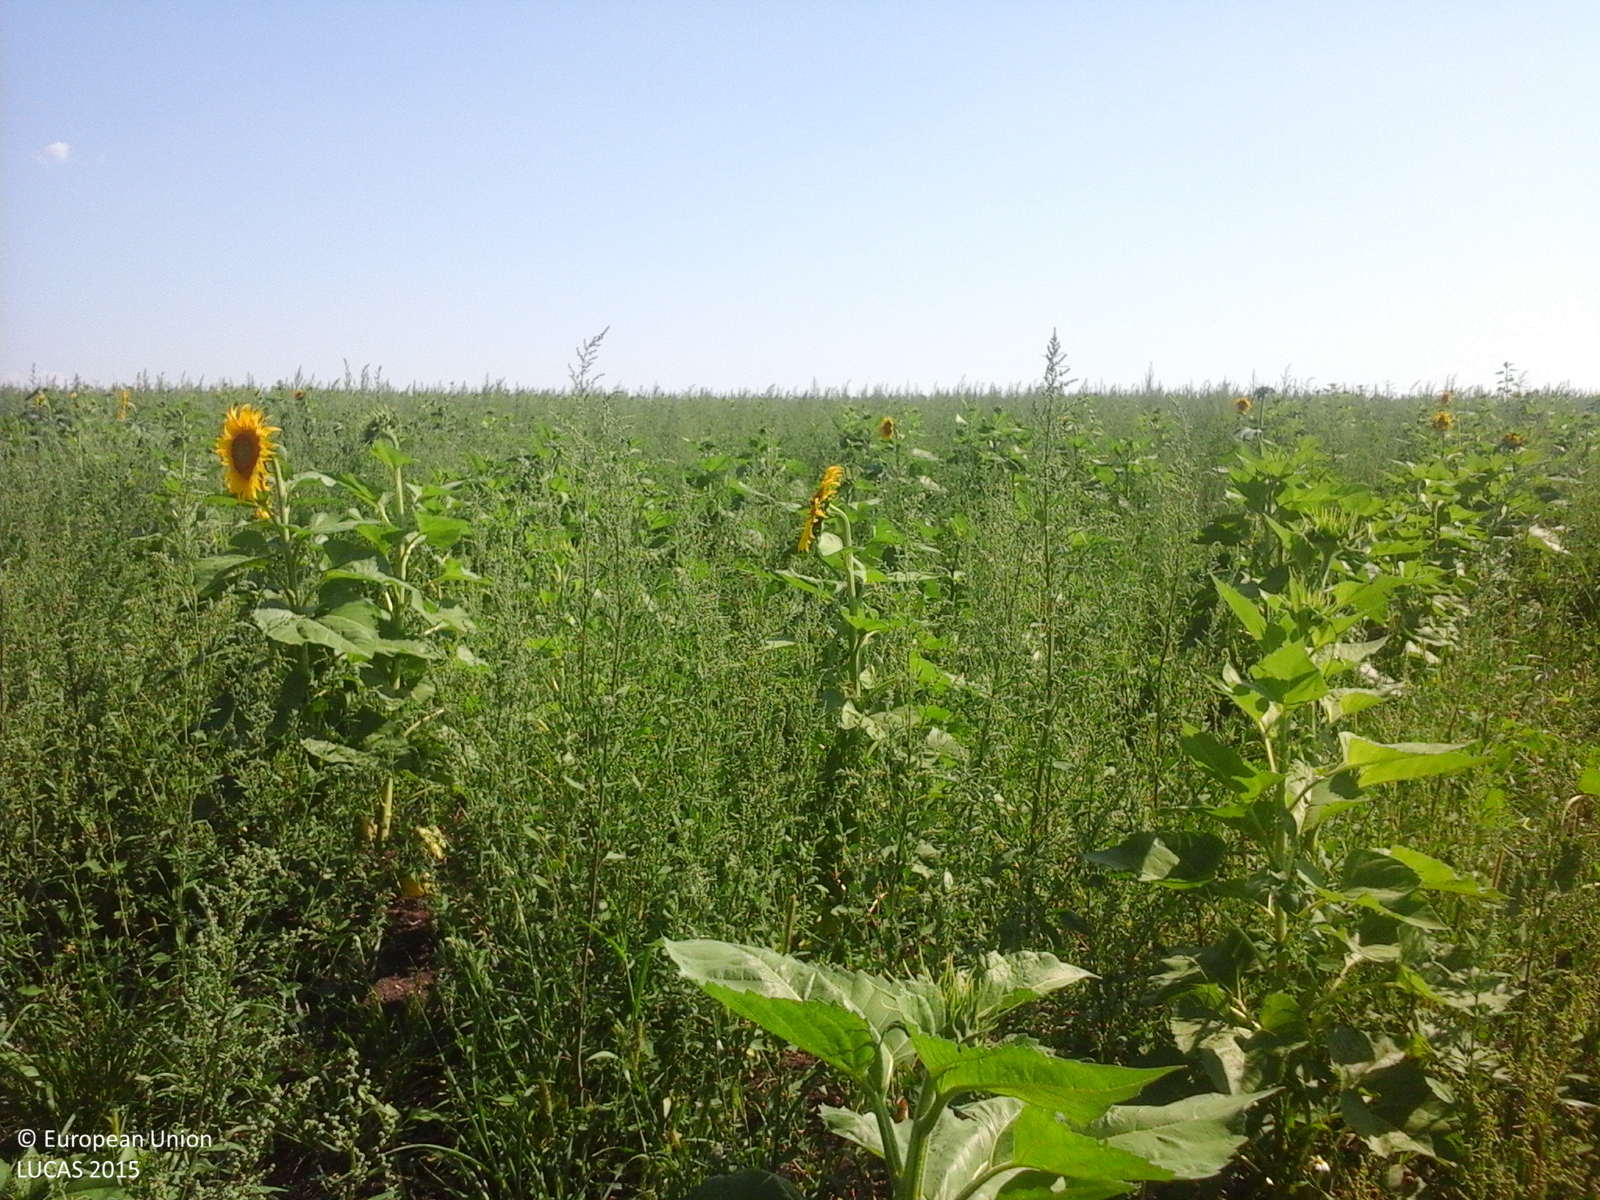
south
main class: Grassland
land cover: Spontaneously vegetated surfaces
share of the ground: > 75 %
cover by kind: herbaceous plants 100 %
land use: Fallow land
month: July
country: RO
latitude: 44.2542
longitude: 24.6630
